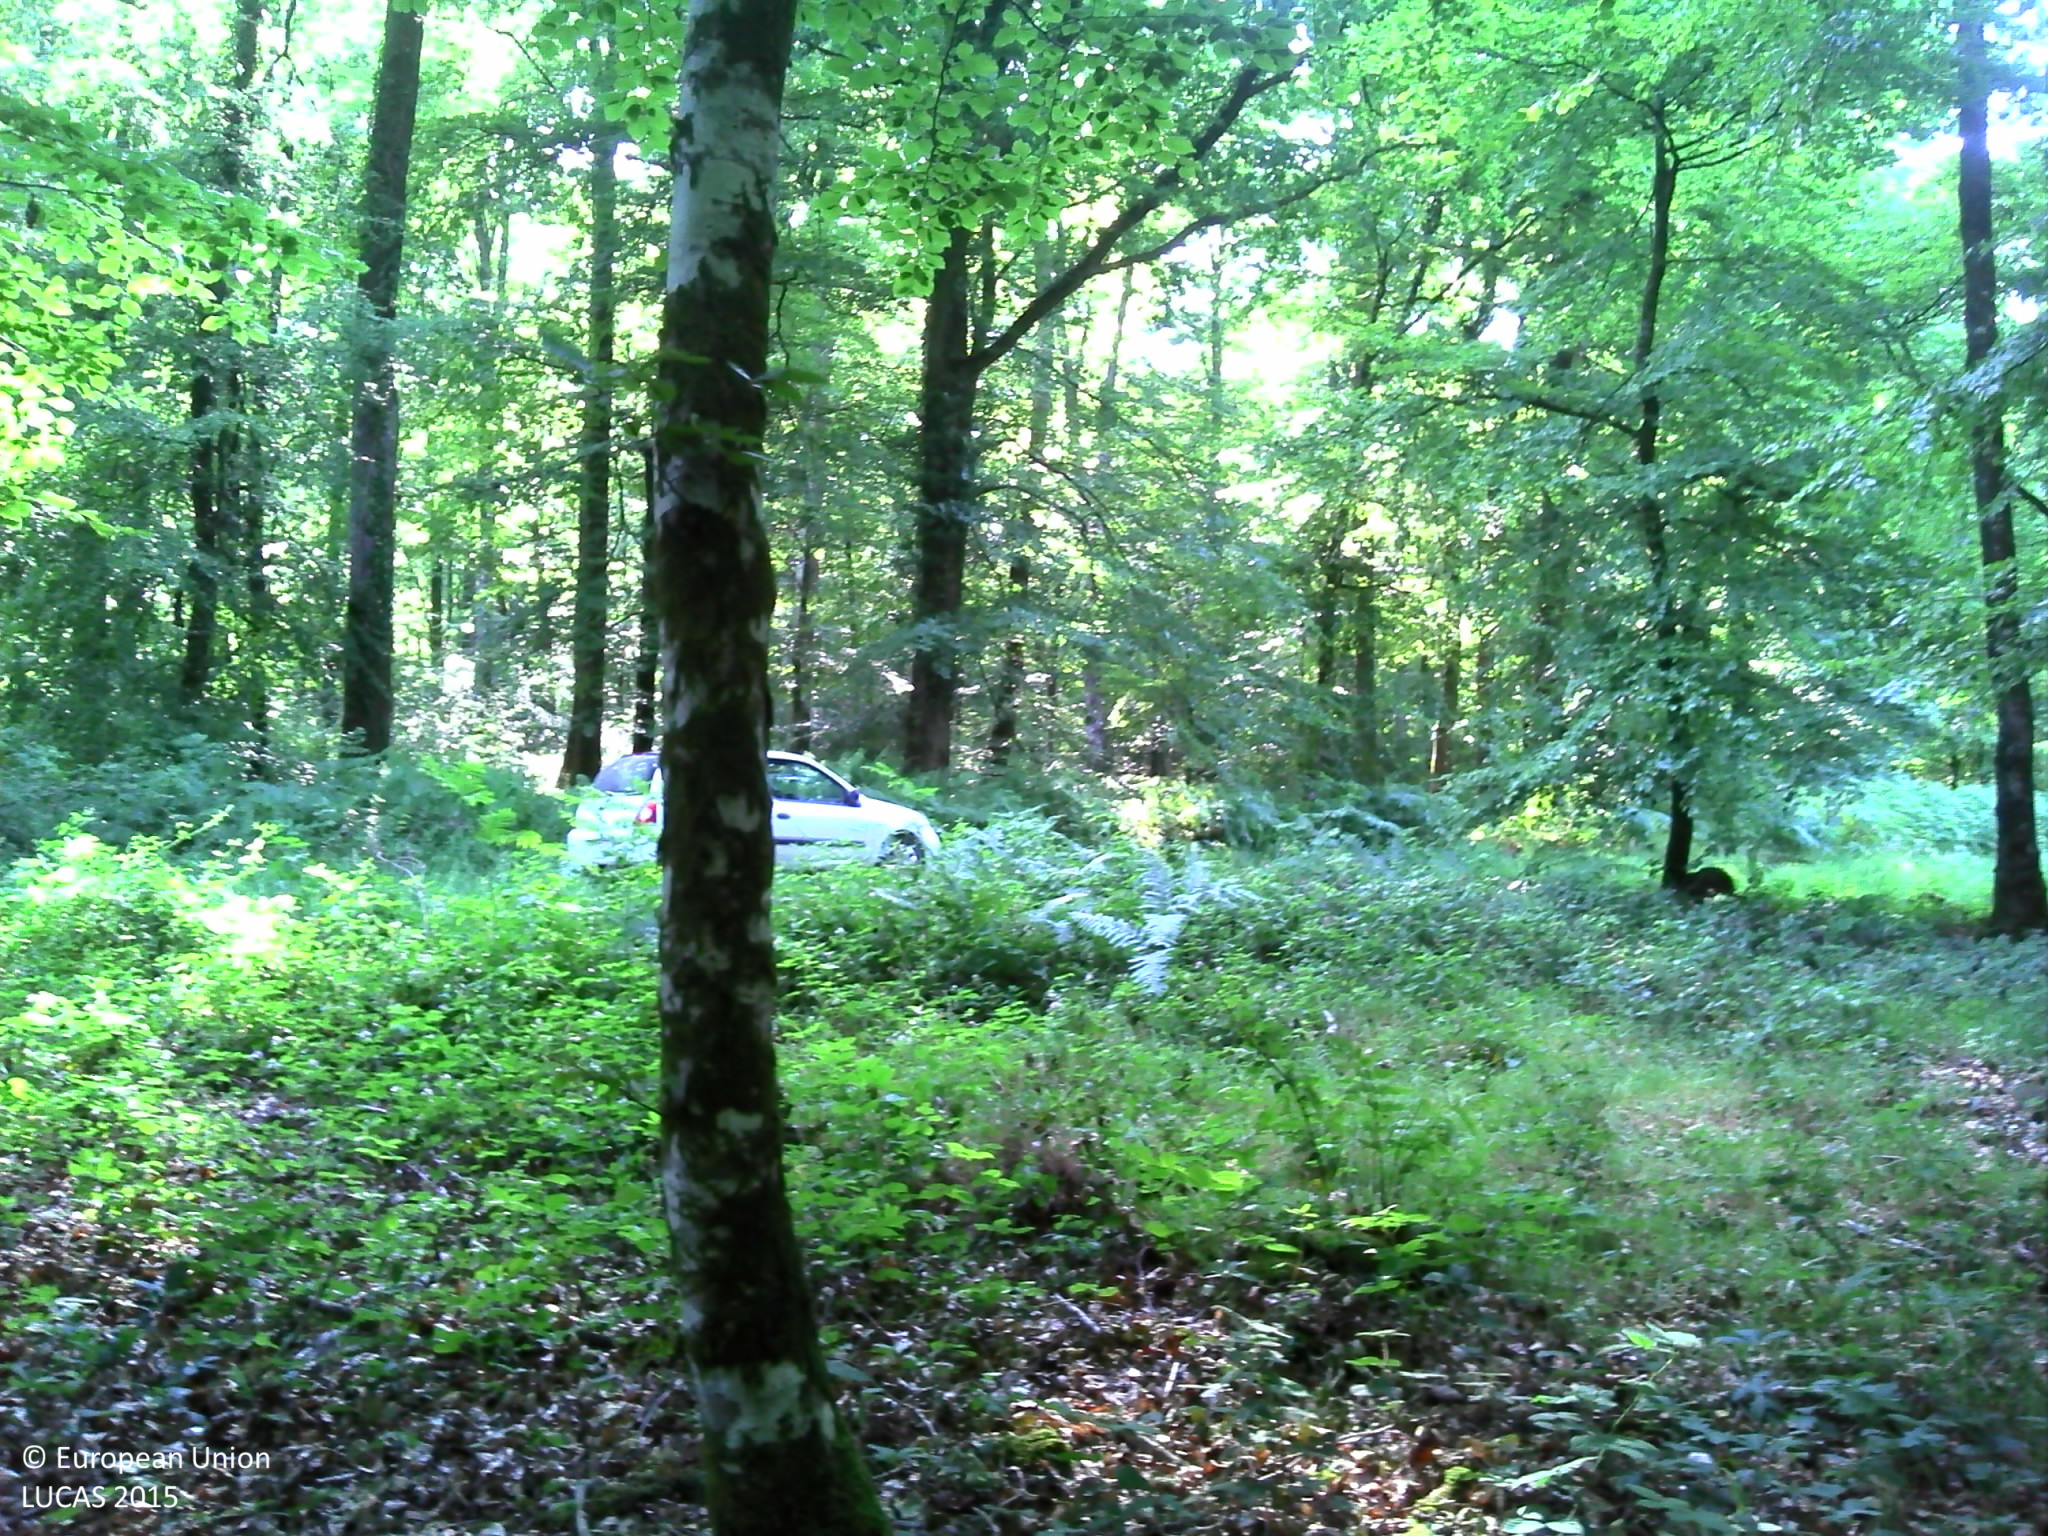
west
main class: Woodland
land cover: Broadleaved woodland
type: acidophilous oak and oak-birch forest
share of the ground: > 75 %
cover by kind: broadleaved forest trees 70 %, shrubs 15 %, herbaceous plants 15 %
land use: Forestry
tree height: > 5 m
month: June
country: FR
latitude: 48.3849
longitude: 0.2100
